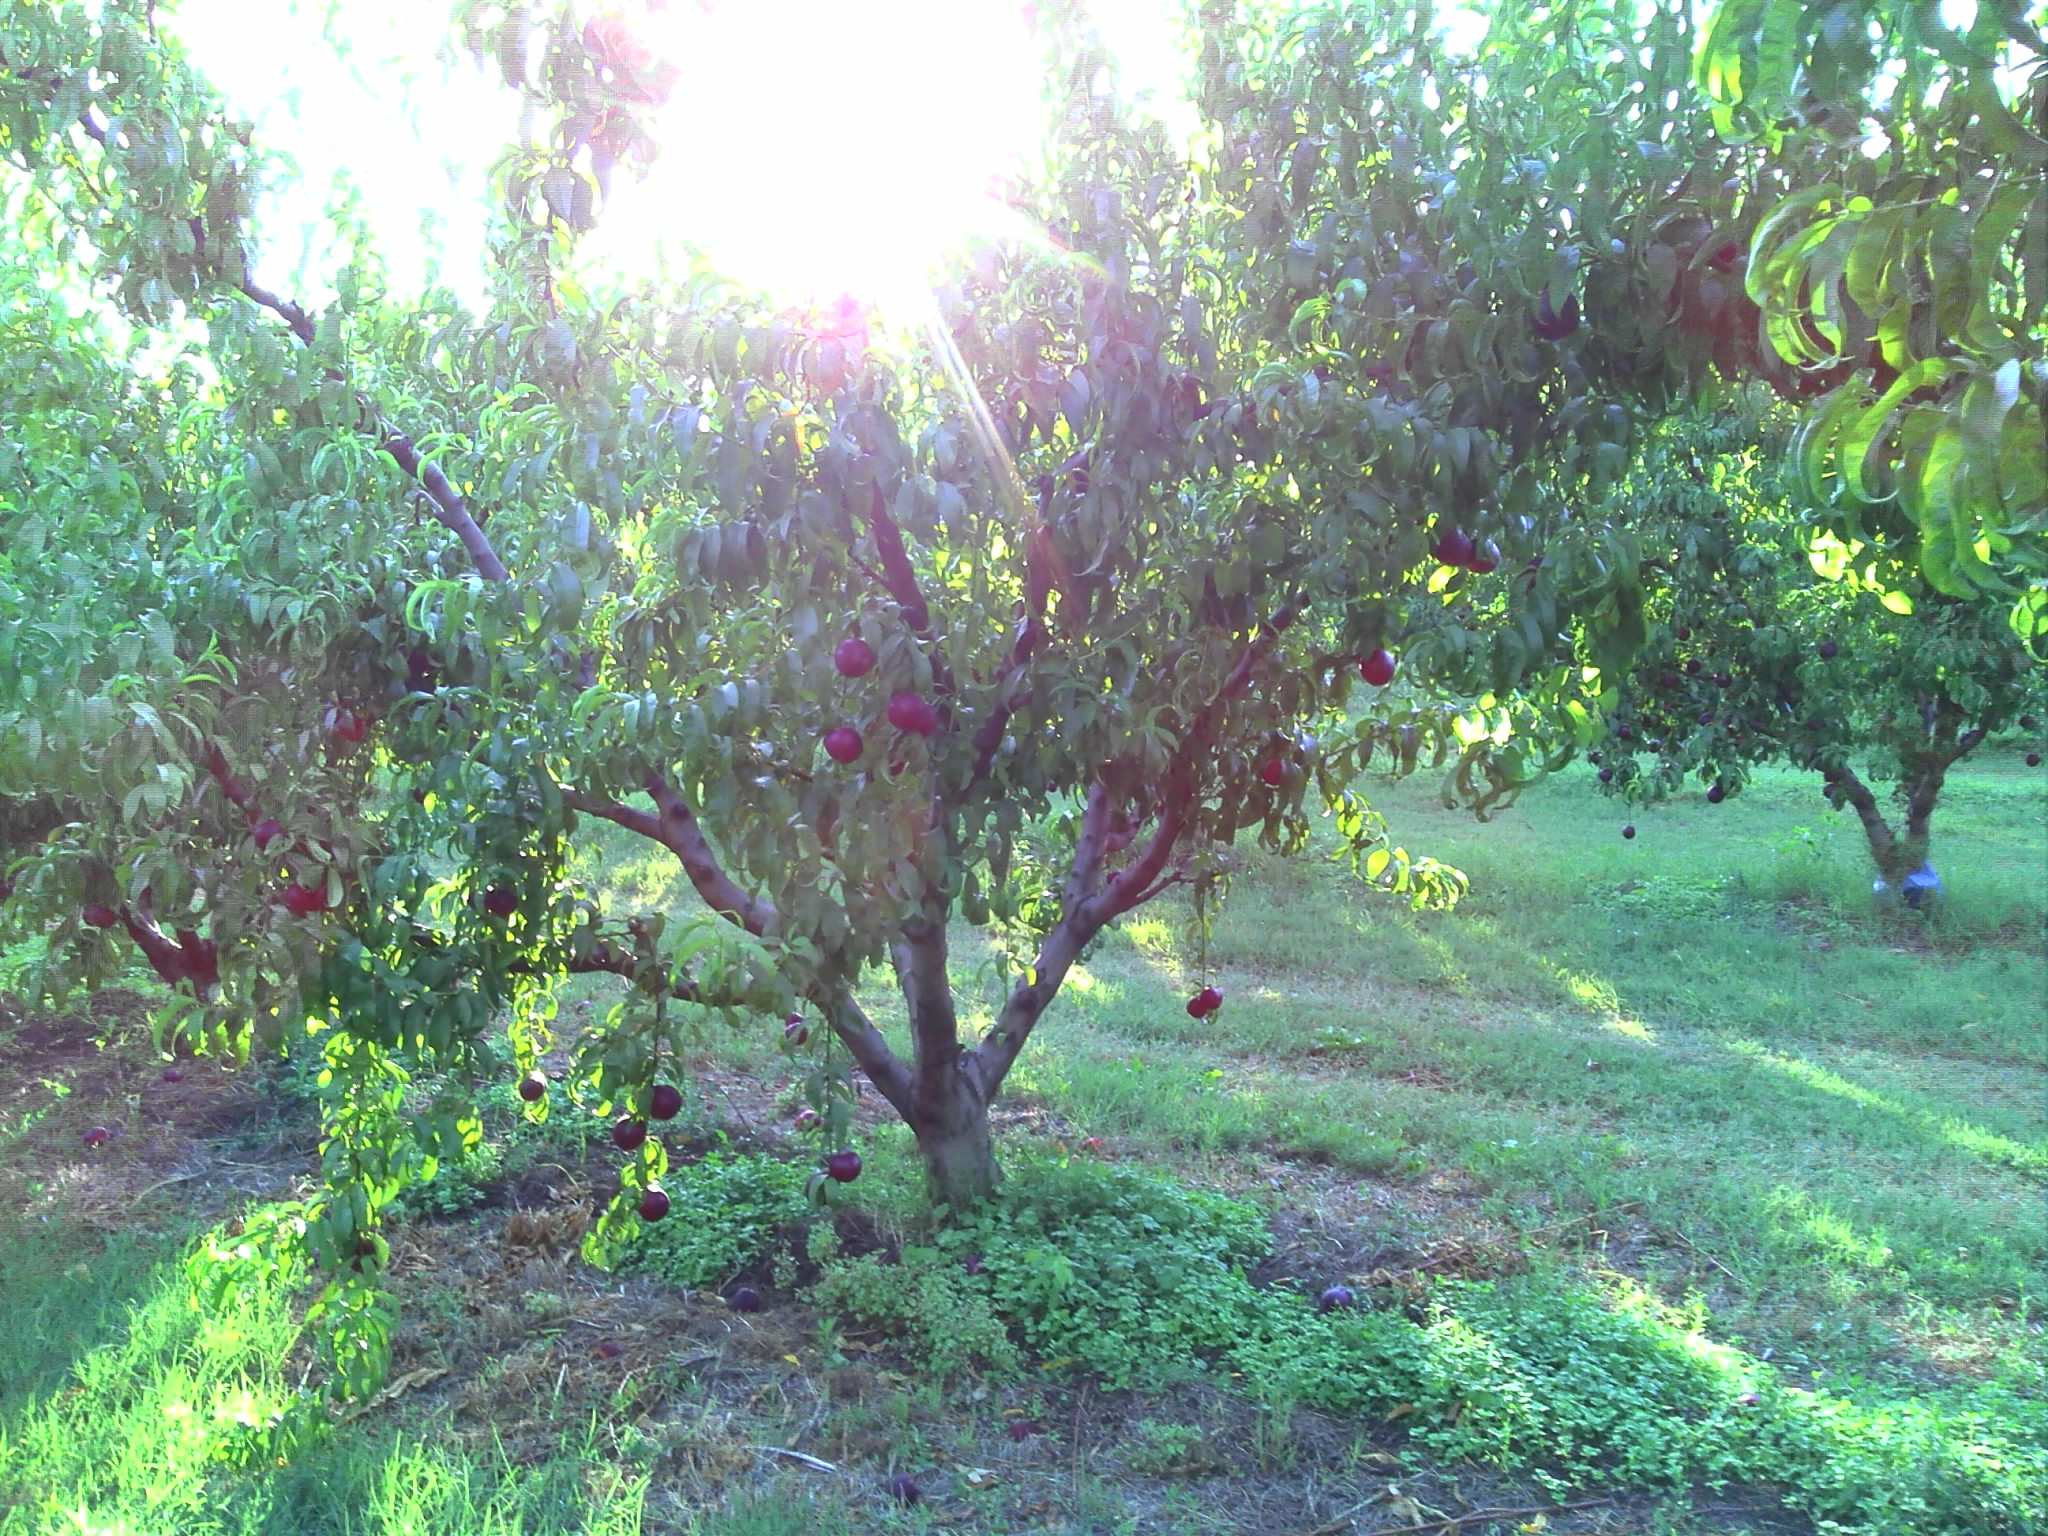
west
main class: Cropland
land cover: Other fruit trees and berries
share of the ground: 50 - 75 %
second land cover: Grassland without tree/shrub cover
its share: 25 - 50 %
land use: Agriculture (excluding fallow land and kitchen gardens)
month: August
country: FR
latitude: 44.2839
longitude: 4.6317
